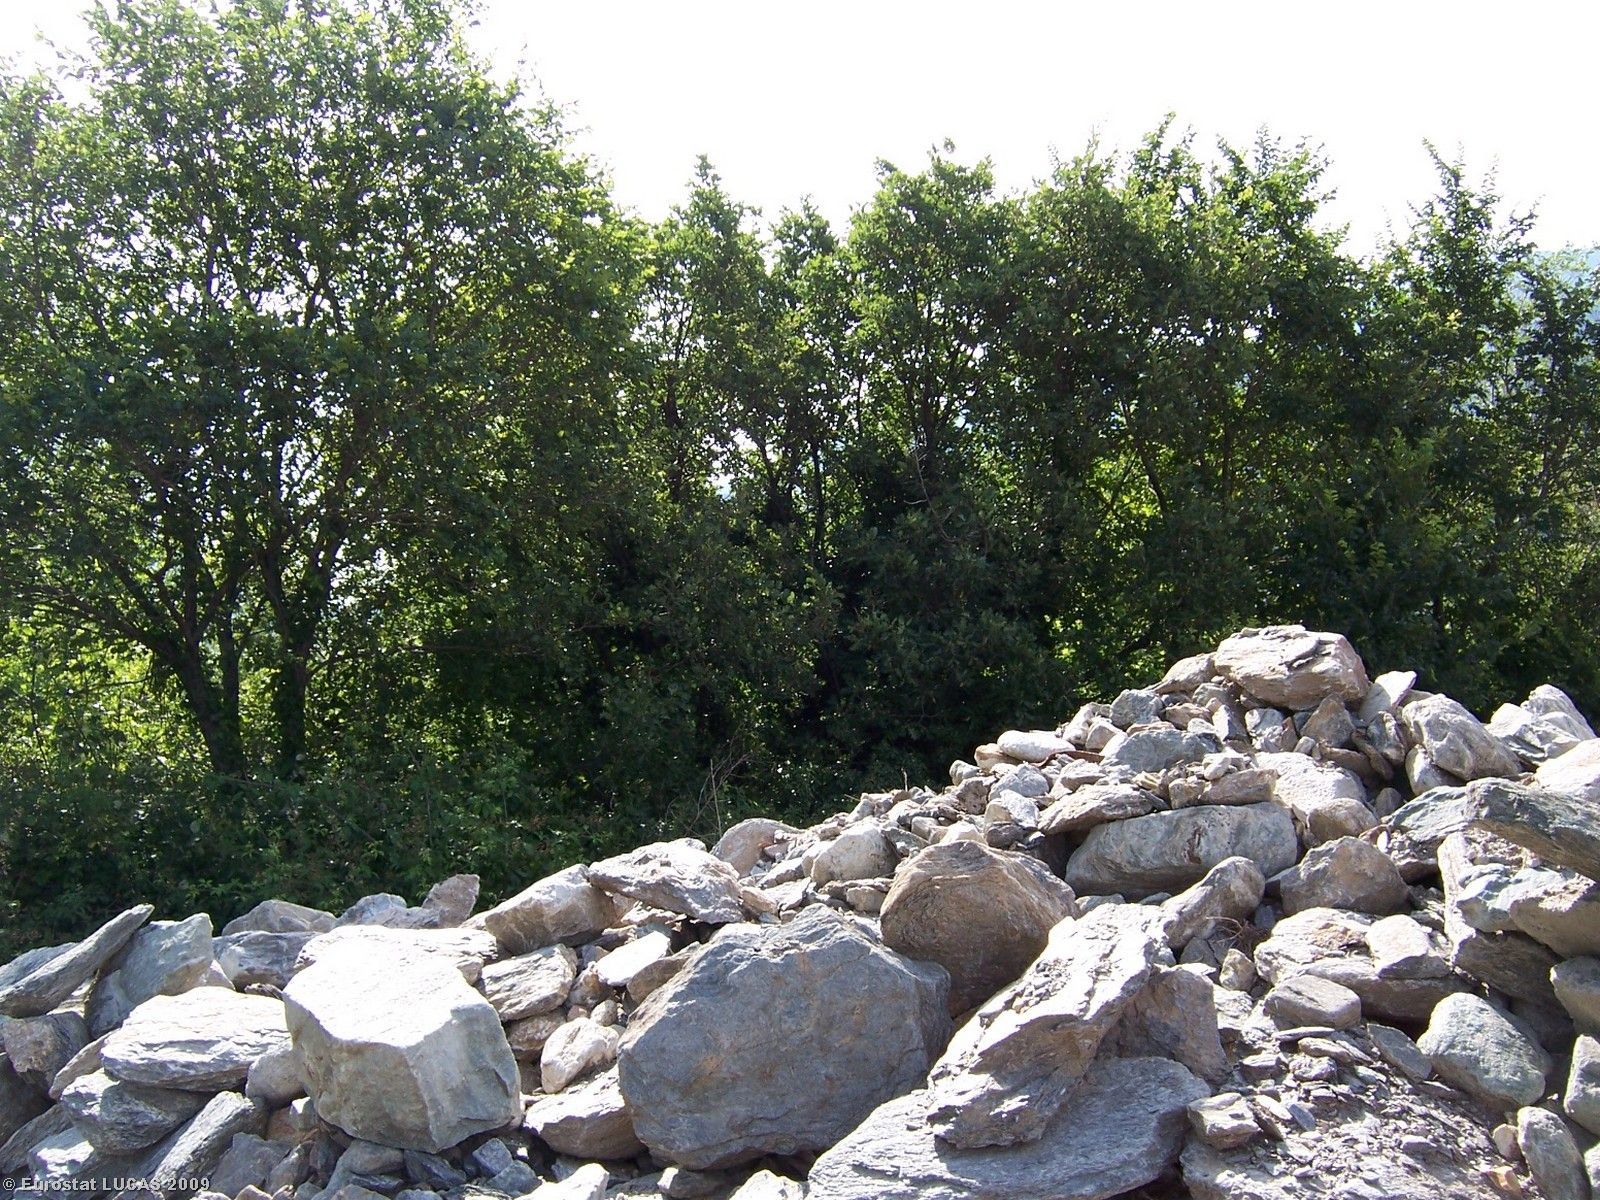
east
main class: Woodland
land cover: Broadleaved woodland
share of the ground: > 75 %
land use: Unused
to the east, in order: Broadleaved woodland; Fences; Dry stone walls; Grassland with sparse tree/shrub cover; Broadleaved woodland; Artificial constructions in urban areas; Broadleaved woodland; Artificial constructions in urban areas
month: July
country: IT
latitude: 45.1391
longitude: 7.0672
